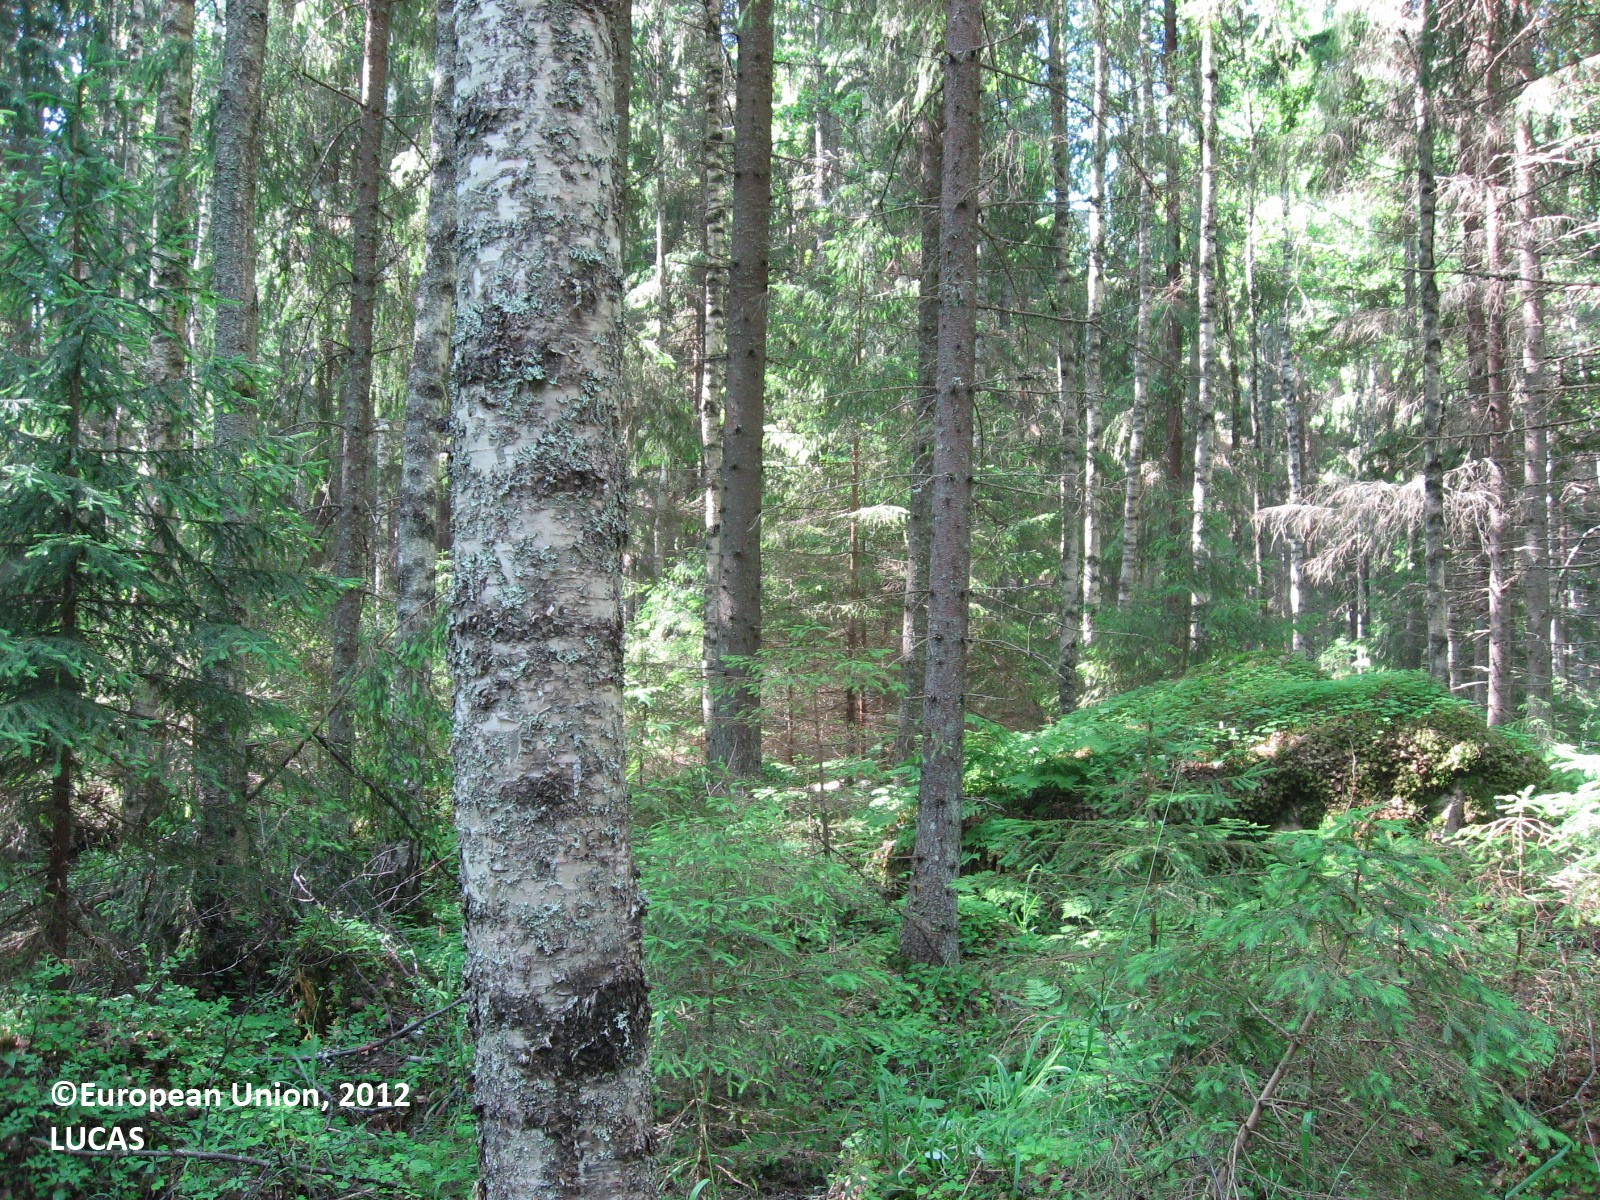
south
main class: Woodland
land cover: Spruce dominated mixed woodland
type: boreal forest
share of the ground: > 75 %
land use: Forestry
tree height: > 5 m
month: June
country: FI
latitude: 60.4618
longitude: 26.4292
